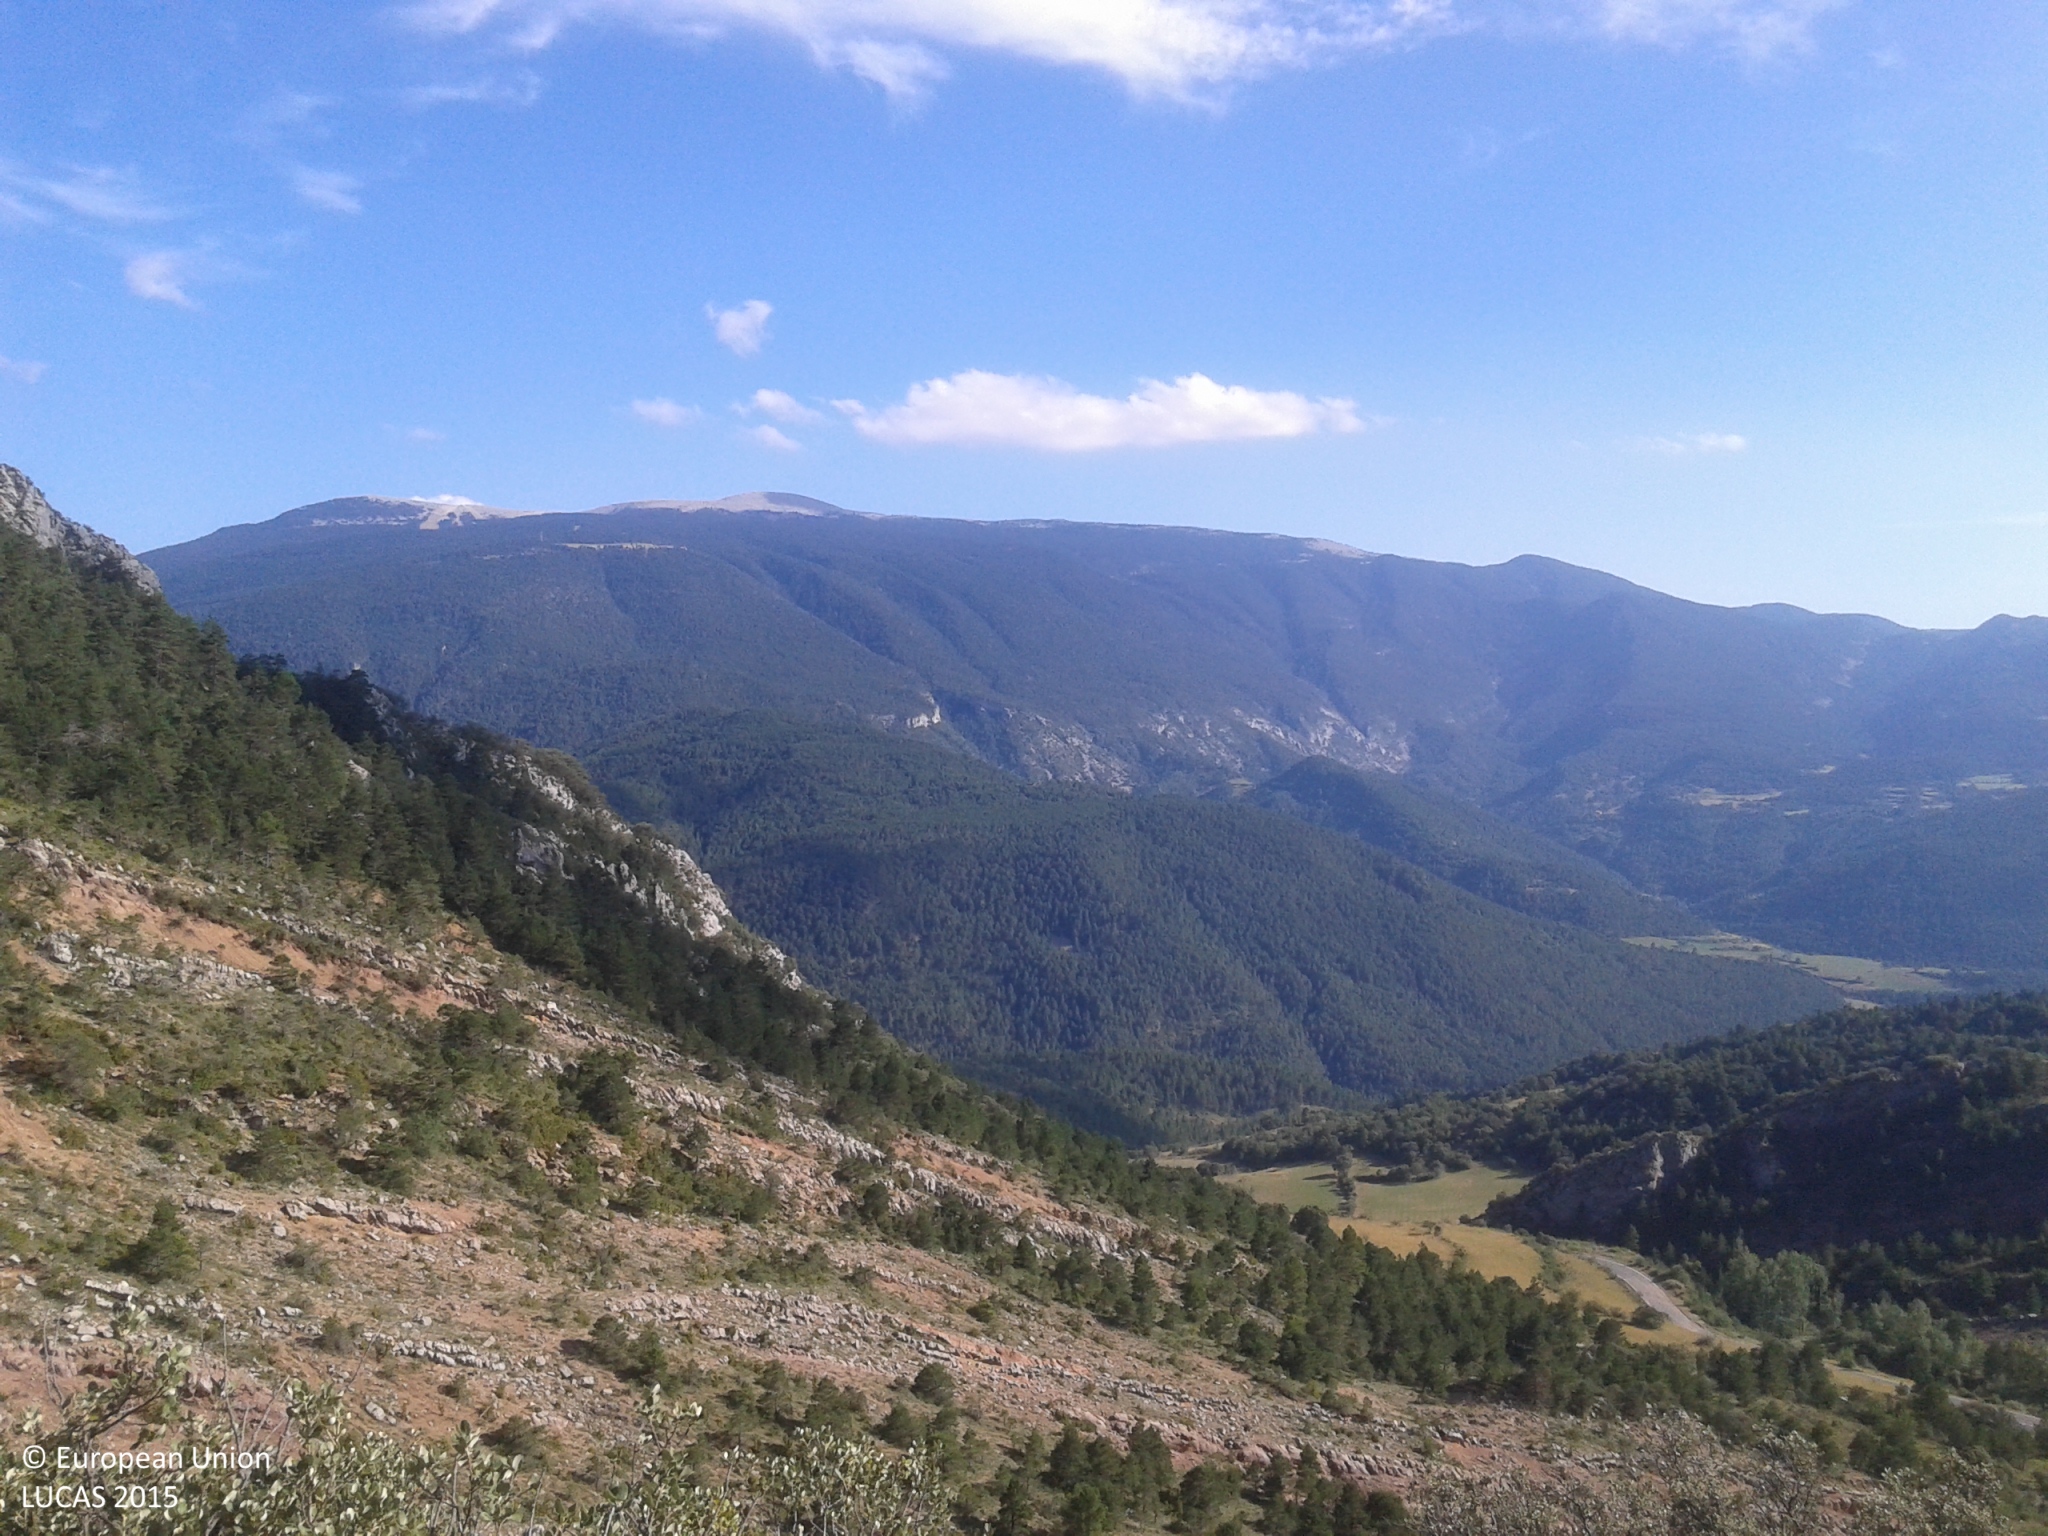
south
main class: Woodland
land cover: Broadleaved woodland
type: broadleaved evergreen forest
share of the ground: 50 - 75 %
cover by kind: broadleaved forest trees 60 %, shrubs 30 %, consolidated bare surface 10 %
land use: Semi-natural and natural areas not in use
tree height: < 5 m
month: July
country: ES
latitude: 42.2610
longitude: 1.5130
